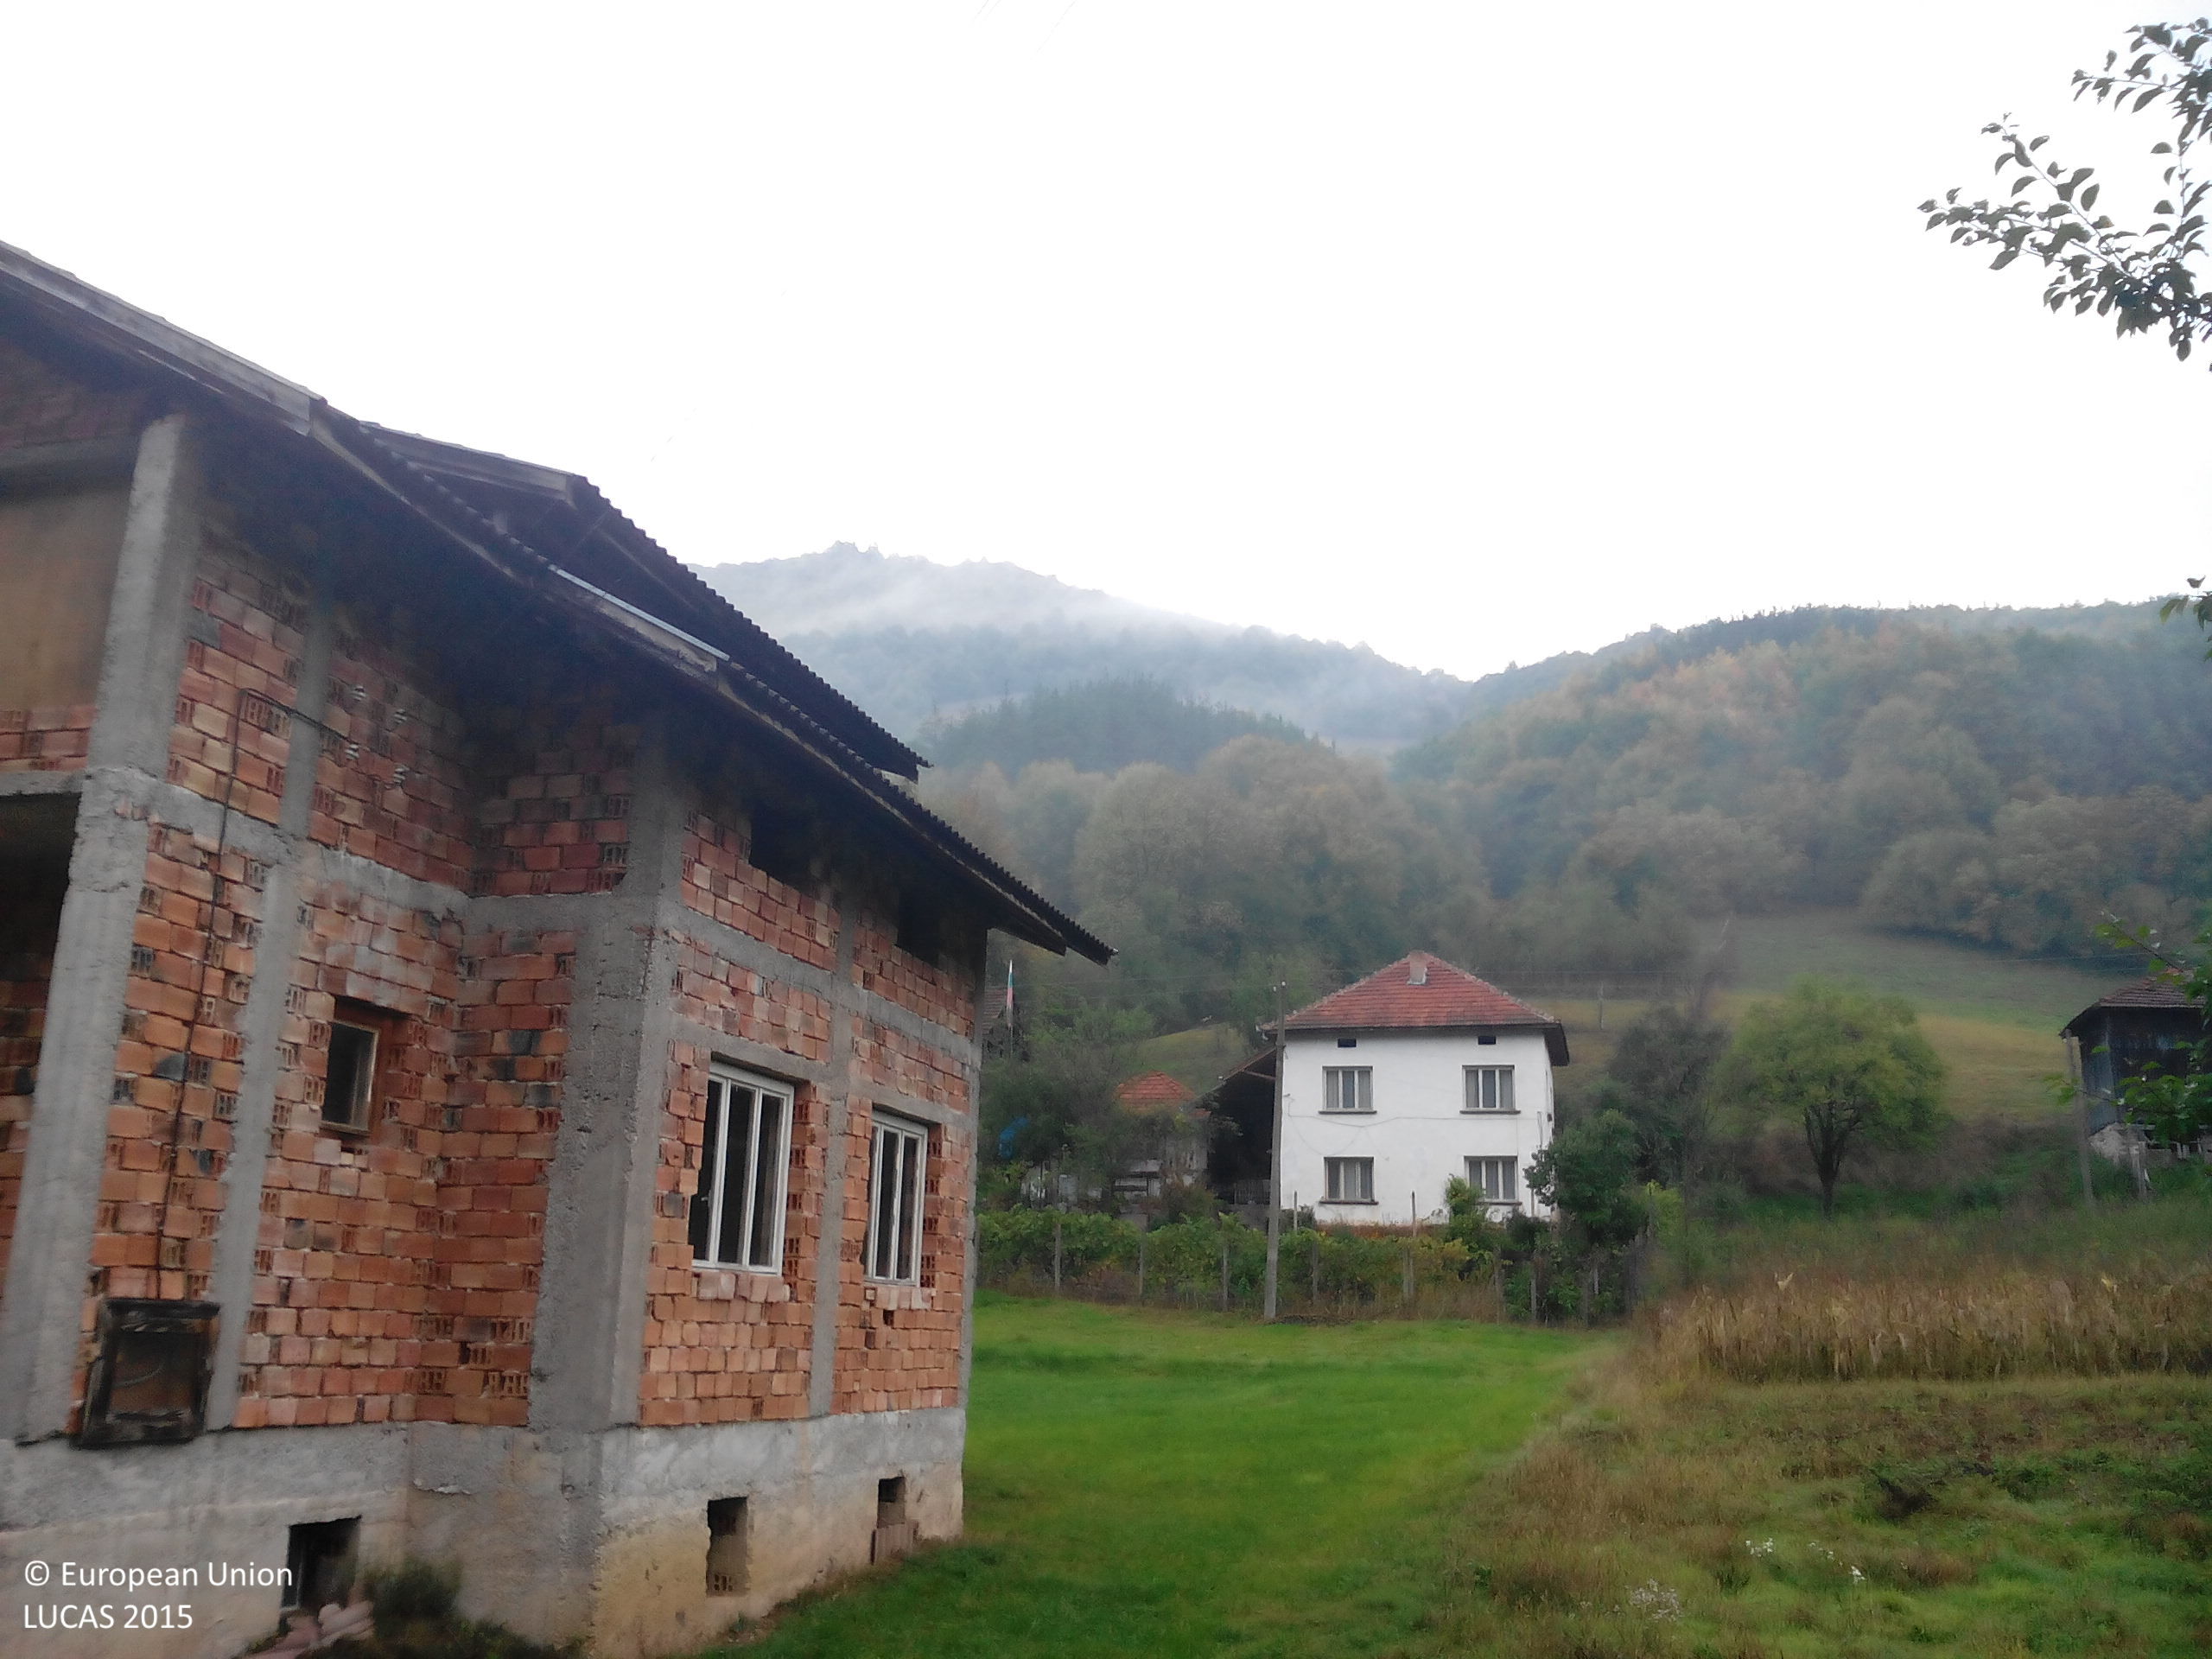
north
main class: Woodland
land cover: Other mixed woodland
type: hemiboreal forest and nemoral coniferous forest and mixed broadleaved-coniferous forest
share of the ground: > 75 %
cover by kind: coniferous forest trees 50 %, broadleaved forest trees 50 %
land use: Forestry
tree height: > 5 m
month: October
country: BG
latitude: 42.8695
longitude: 24.3622
